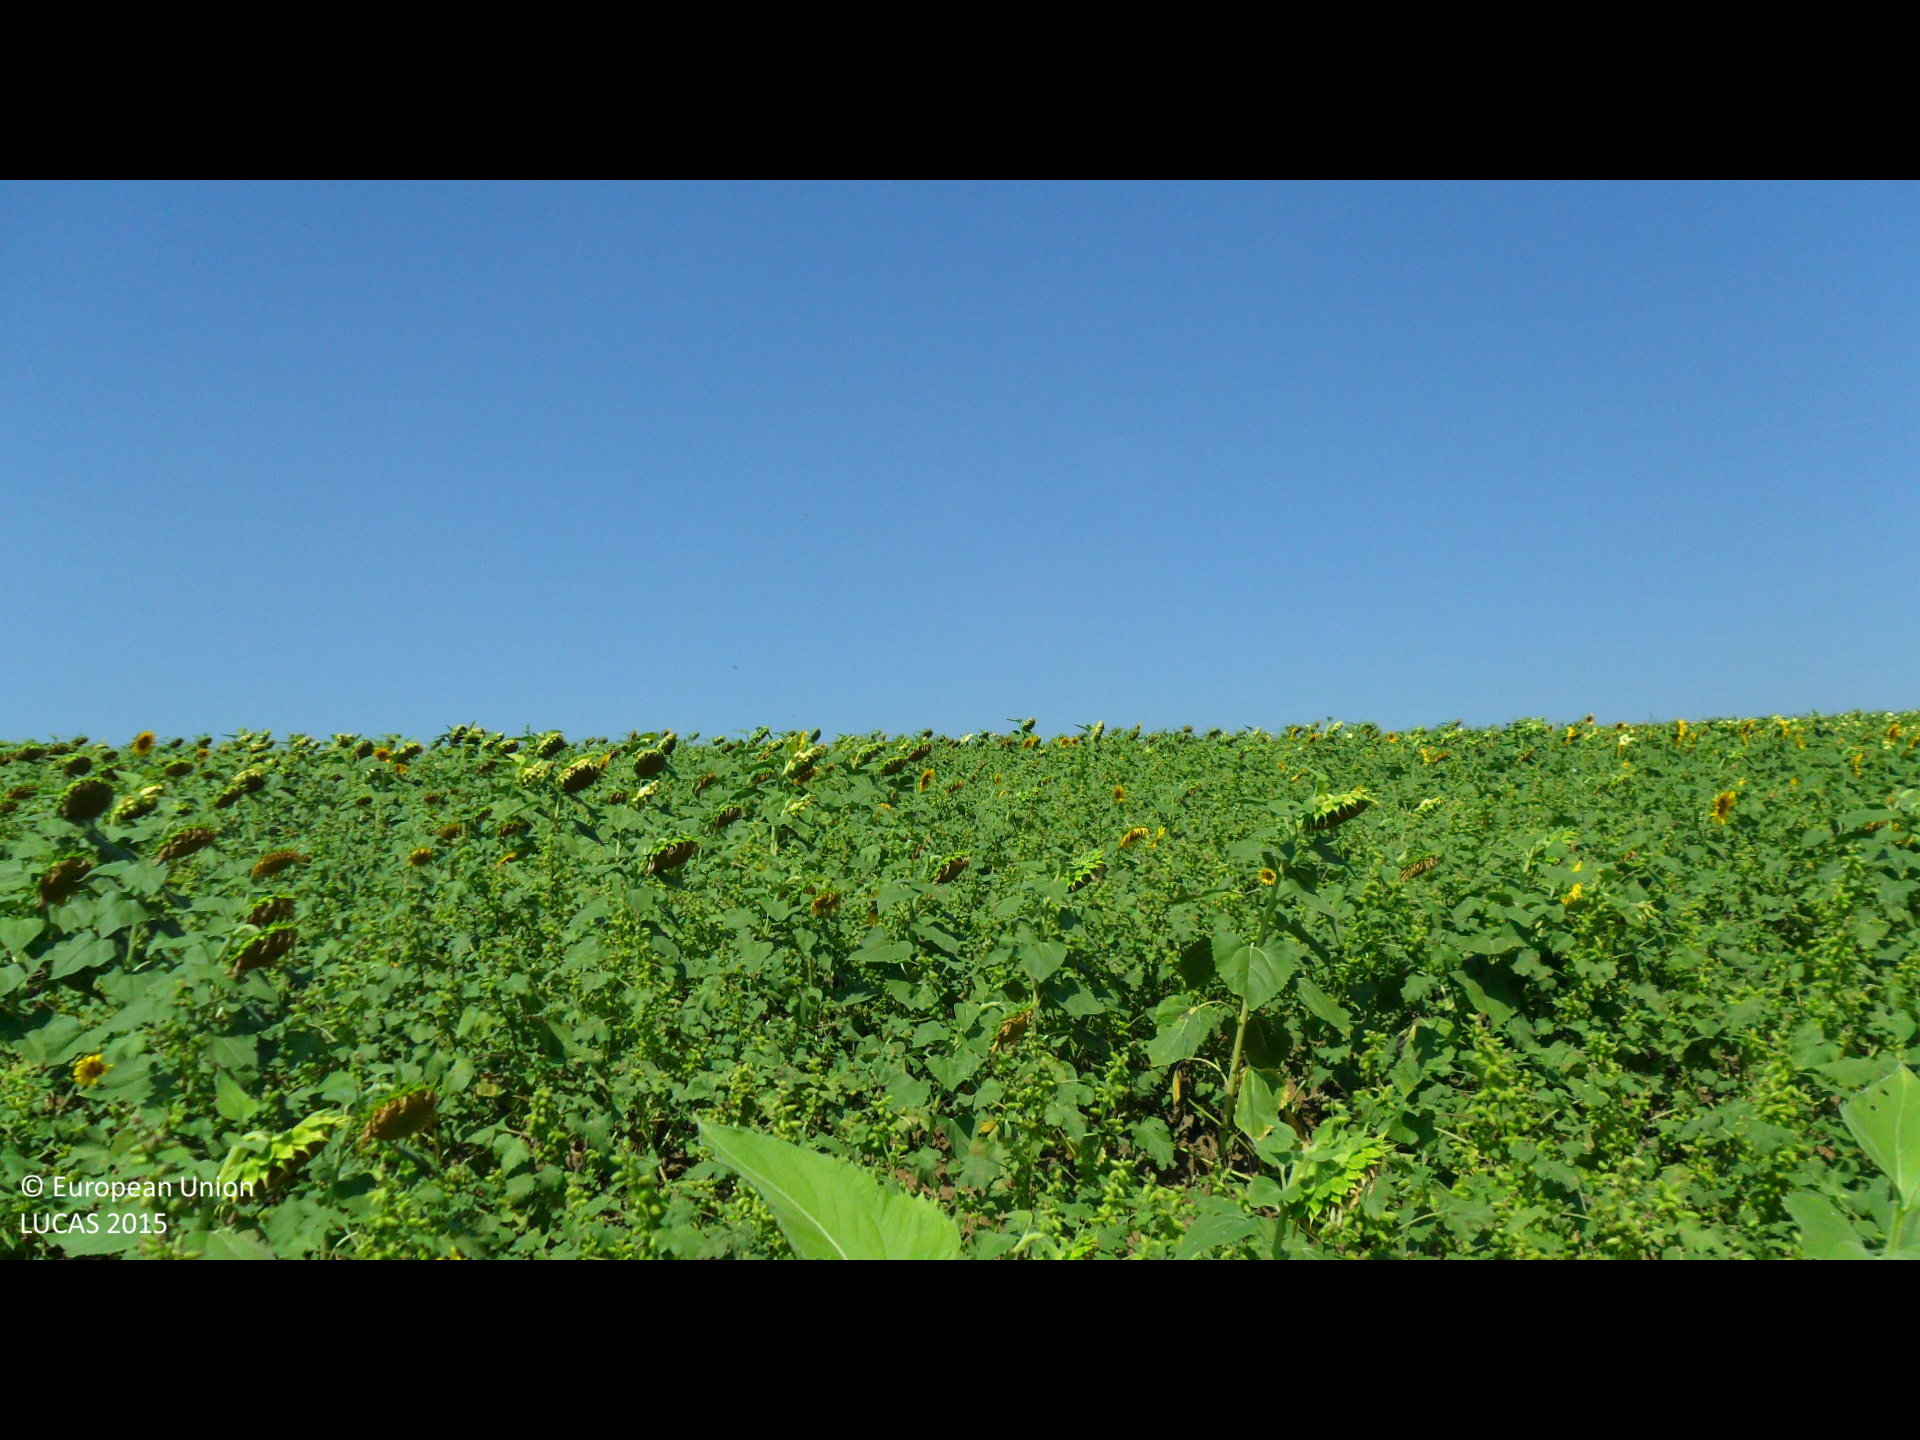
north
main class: Cropland
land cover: Sunflower
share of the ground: > 75 %
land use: Agriculture (excluding fallow land and kitchen gardens)
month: August
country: BG
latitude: 43.2171
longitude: 26.4100
